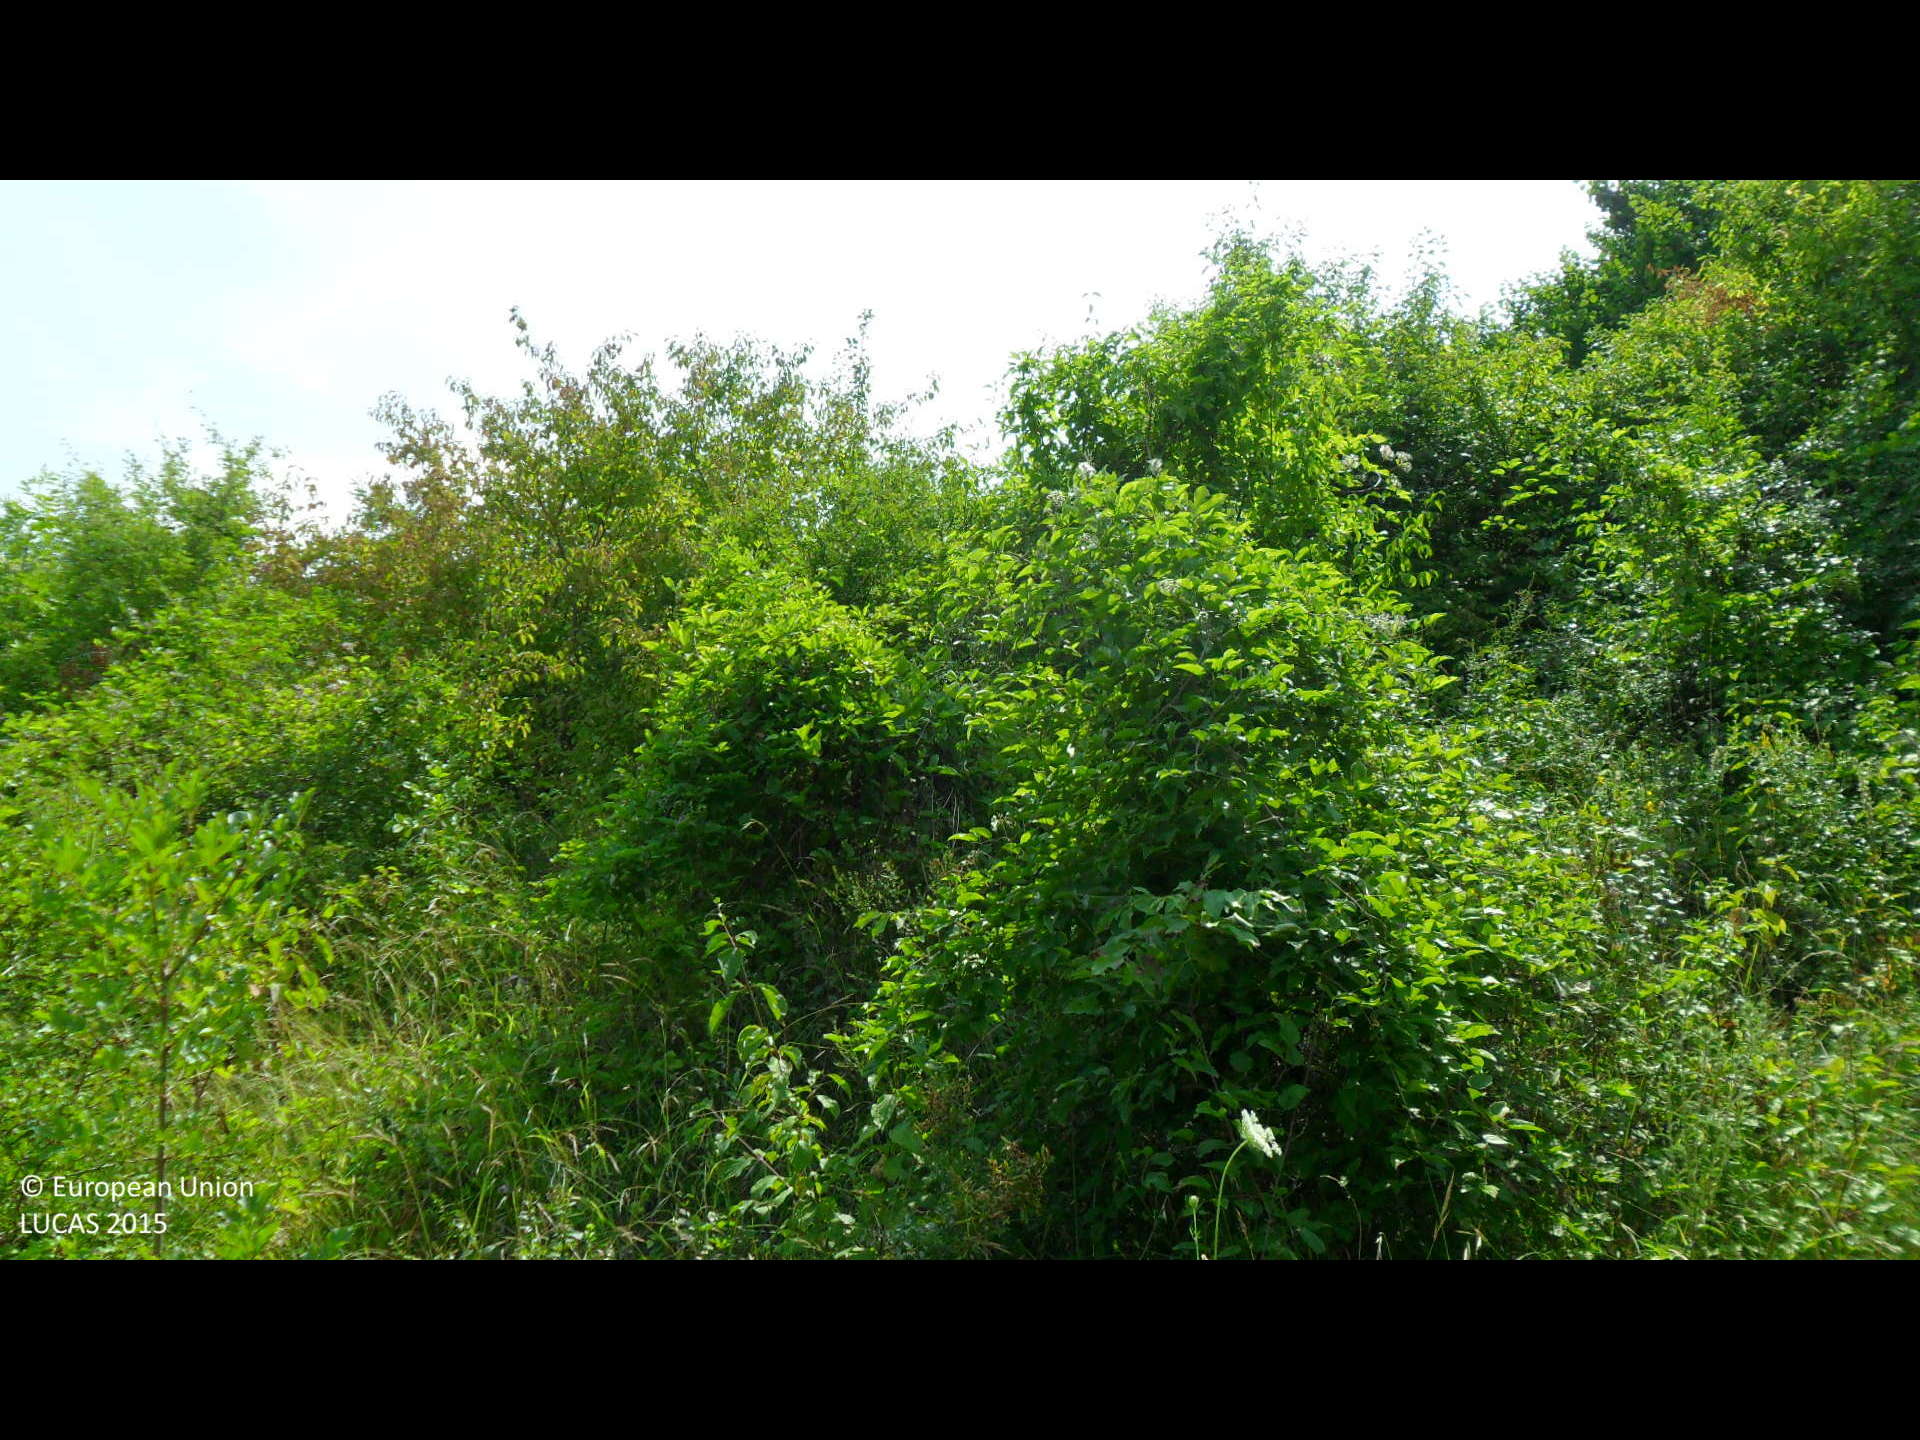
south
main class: Woodland
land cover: Broadleaved woodland
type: mesophytic deciduous forest
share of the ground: > 75 %
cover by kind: broadleaved forest trees 90 %, shrubs 10 %
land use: Forestry
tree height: > 5 m
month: July
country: BG
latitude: 43.3596
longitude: 26.3244
